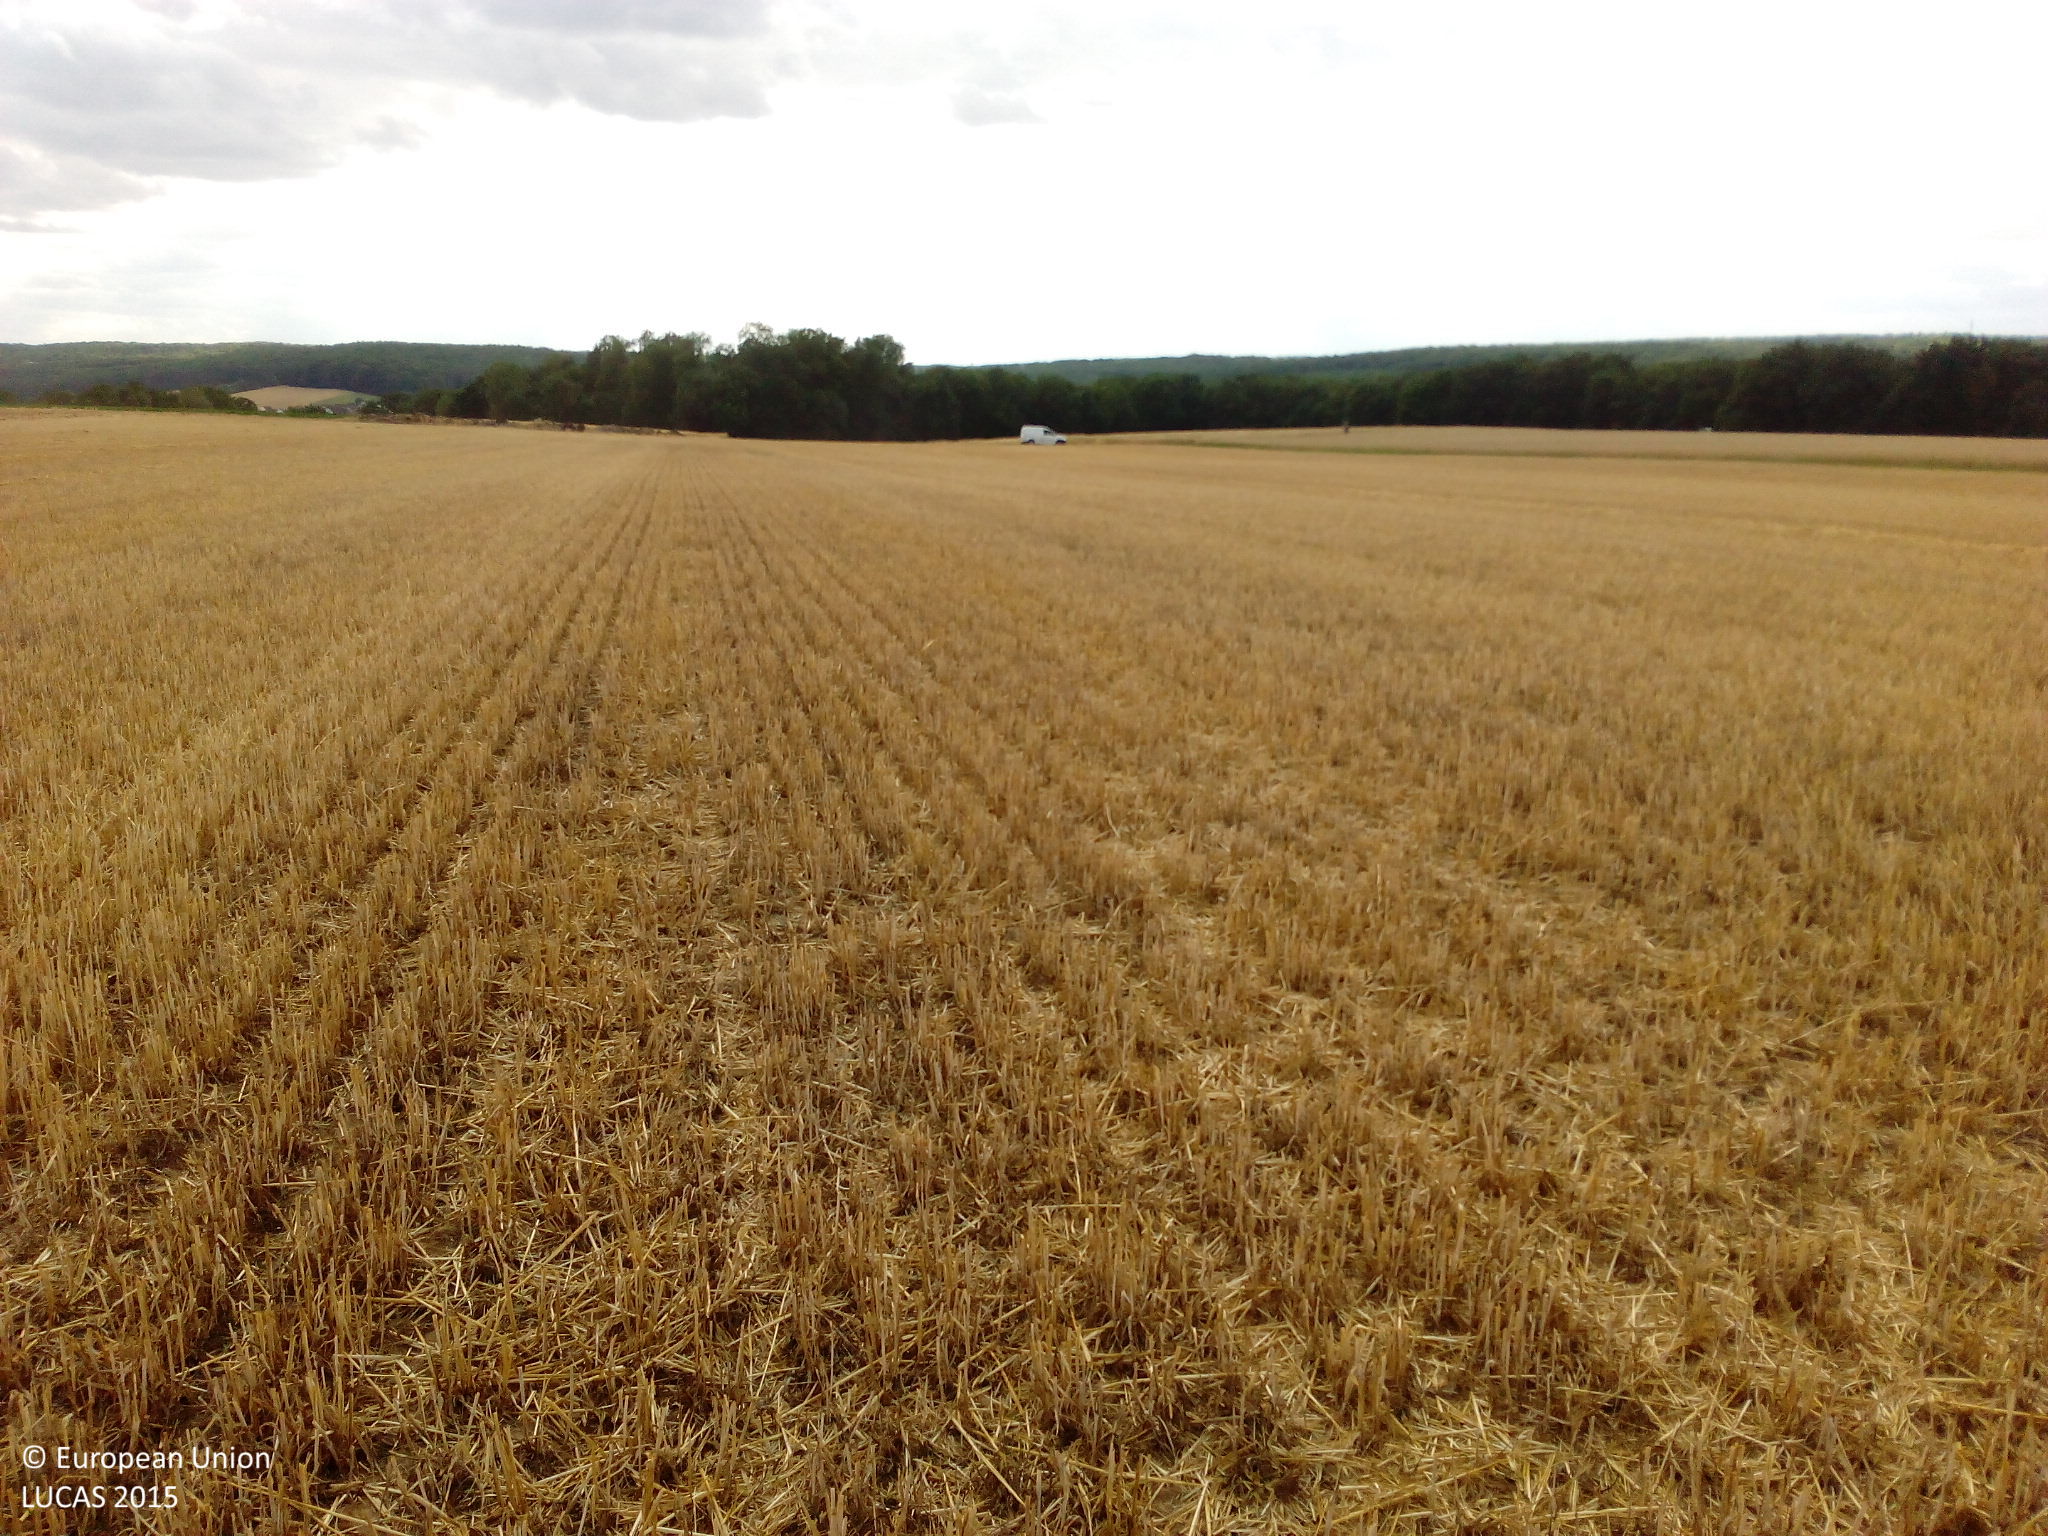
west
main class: Cropland
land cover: Barley
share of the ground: 50 - 75 %
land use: Agriculture (excluding fallow land and kitchen gardens)
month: July
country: DE
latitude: 49.7346
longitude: 9.9307
